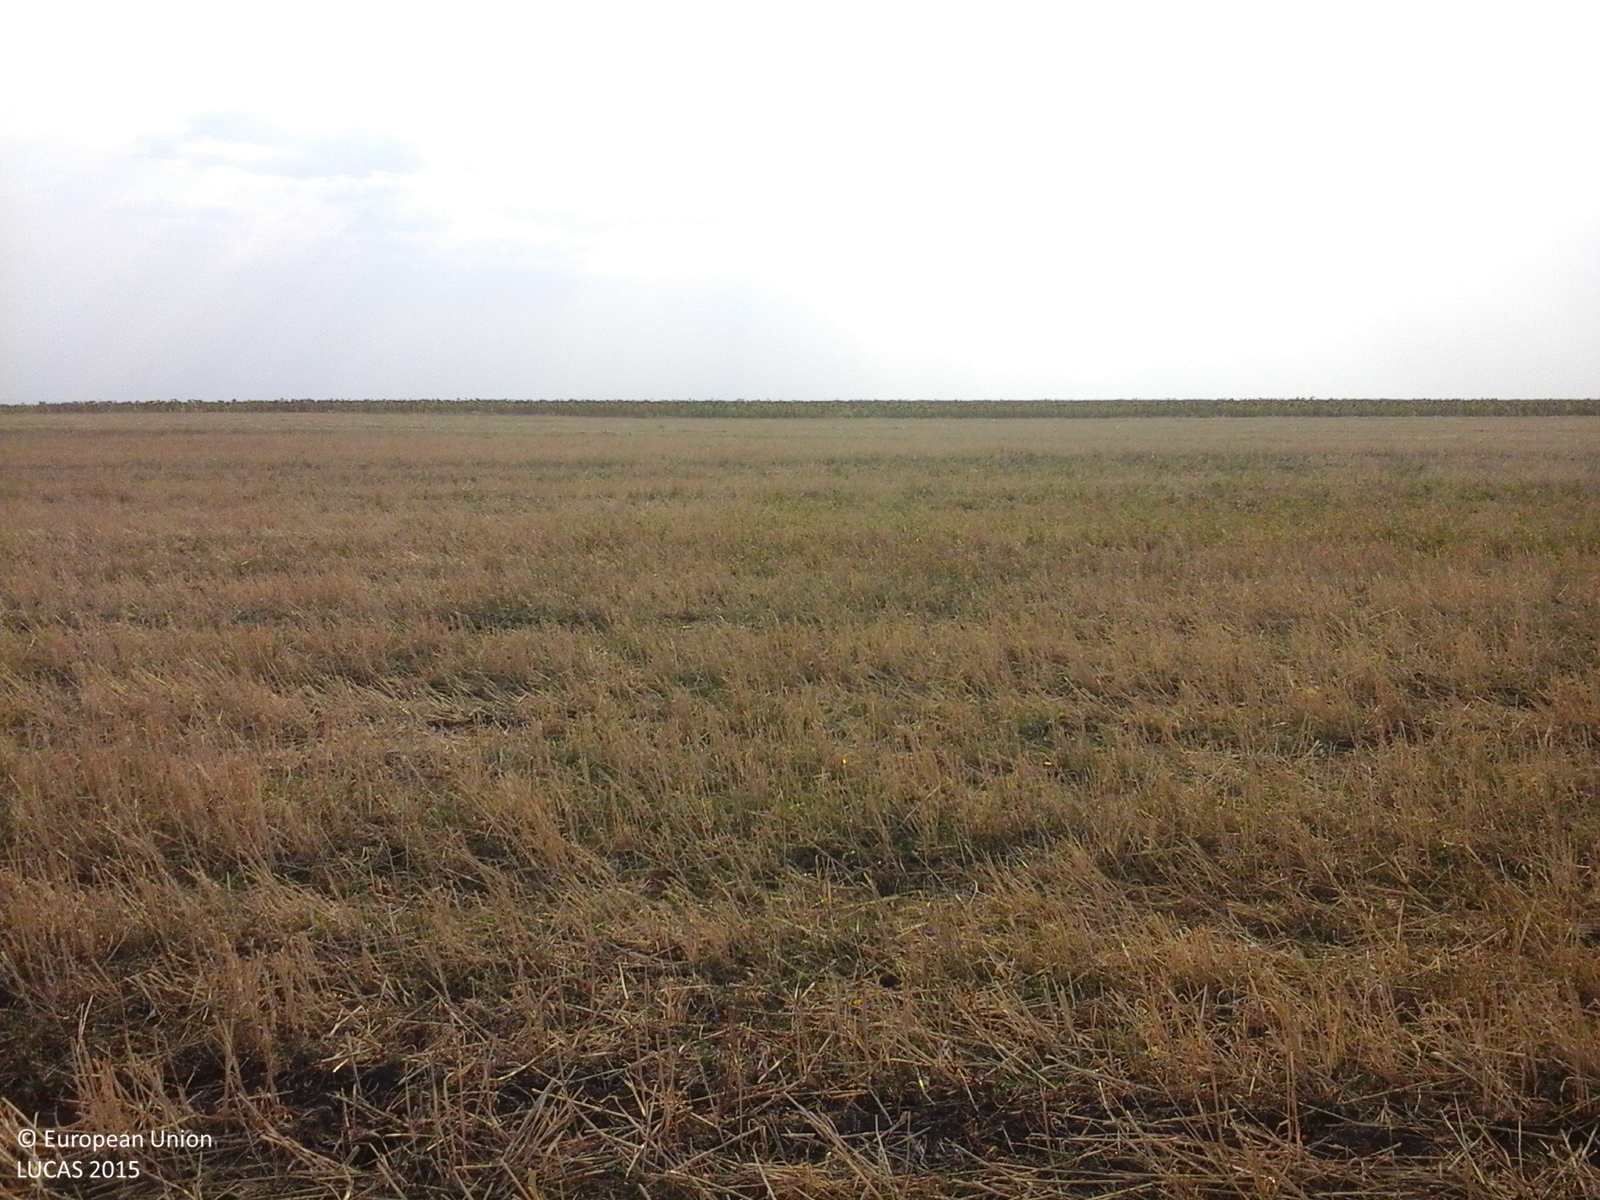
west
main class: Cropland
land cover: Common wheat
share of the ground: 25 - 50 %
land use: Agriculture (excluding fallow land and kitchen gardens)
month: August
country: RO
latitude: 44.2454
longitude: 23.1061
